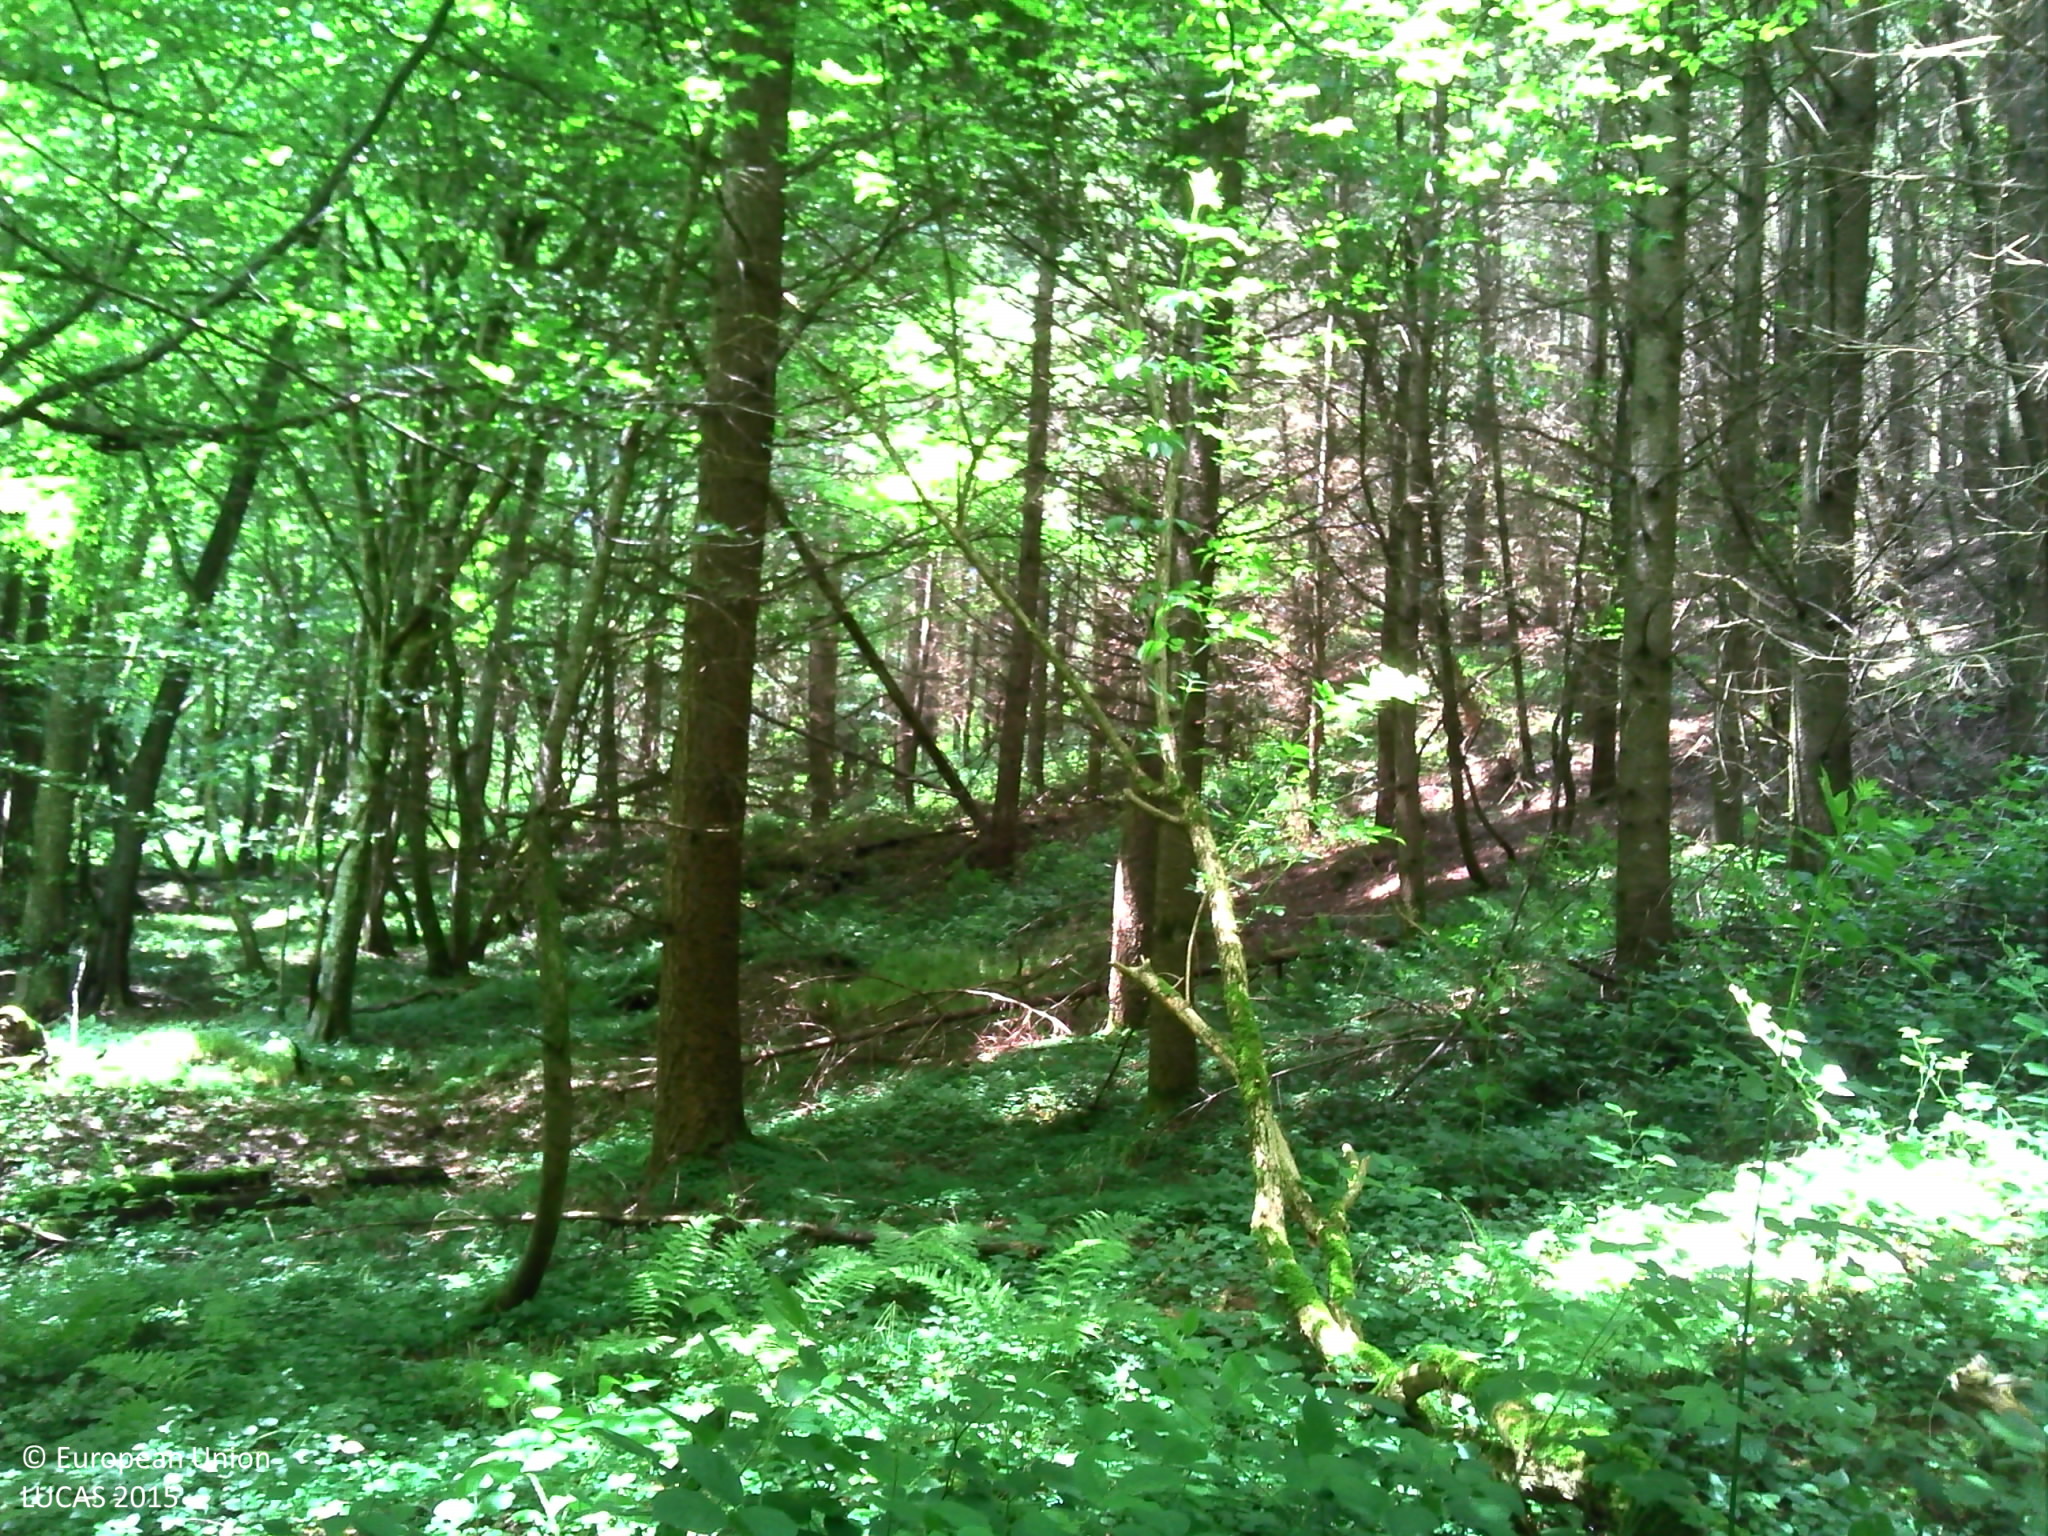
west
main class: Woodland
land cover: Pine dominated mixed woodland
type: acidophilous oak and oak-birch forest
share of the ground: > 75 %
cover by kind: broadleaved forest trees 70 %, coniferous forest trees 25 %, herbaceous plants 5 %
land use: Forestry
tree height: > 5 m
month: June
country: FR
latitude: 46.1591
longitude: 3.0184
